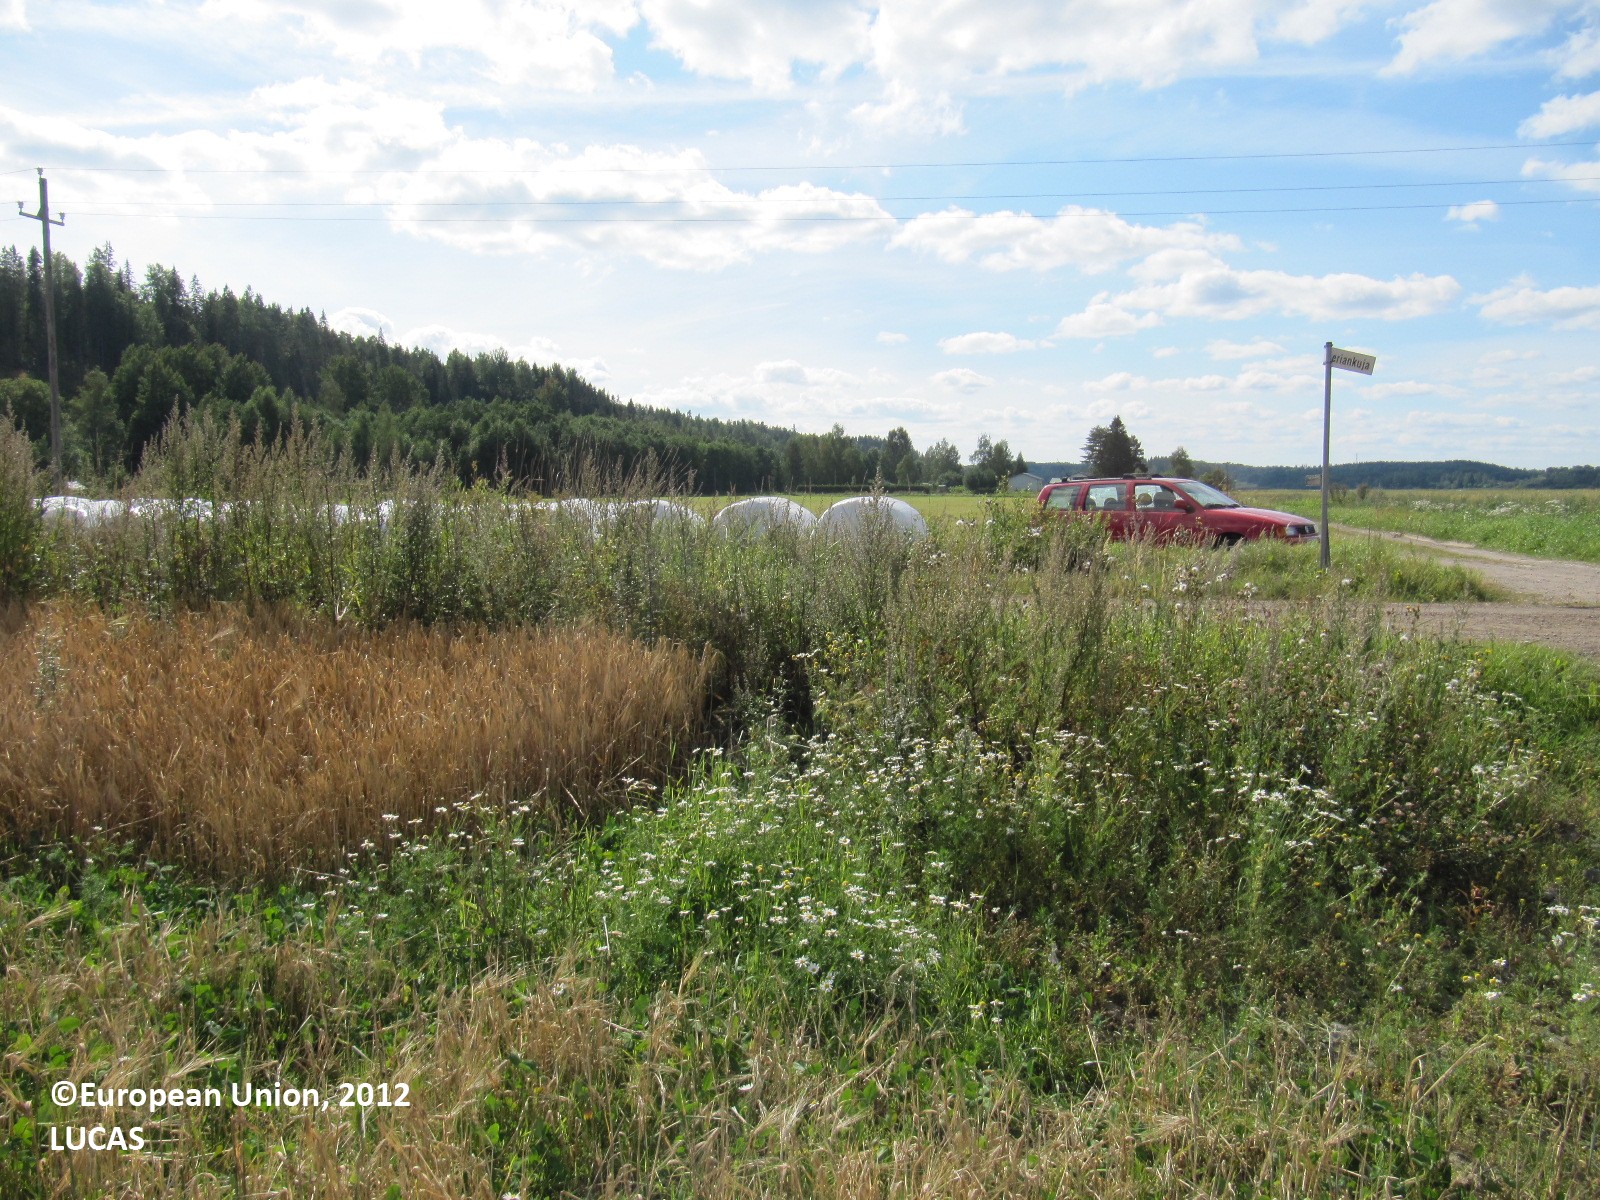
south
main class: Cropland
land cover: Barley
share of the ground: > 75 %
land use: Agriculture (excluding fallow land and kitchen gardens)
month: August
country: FI
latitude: 60.4658
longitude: 24.3803
